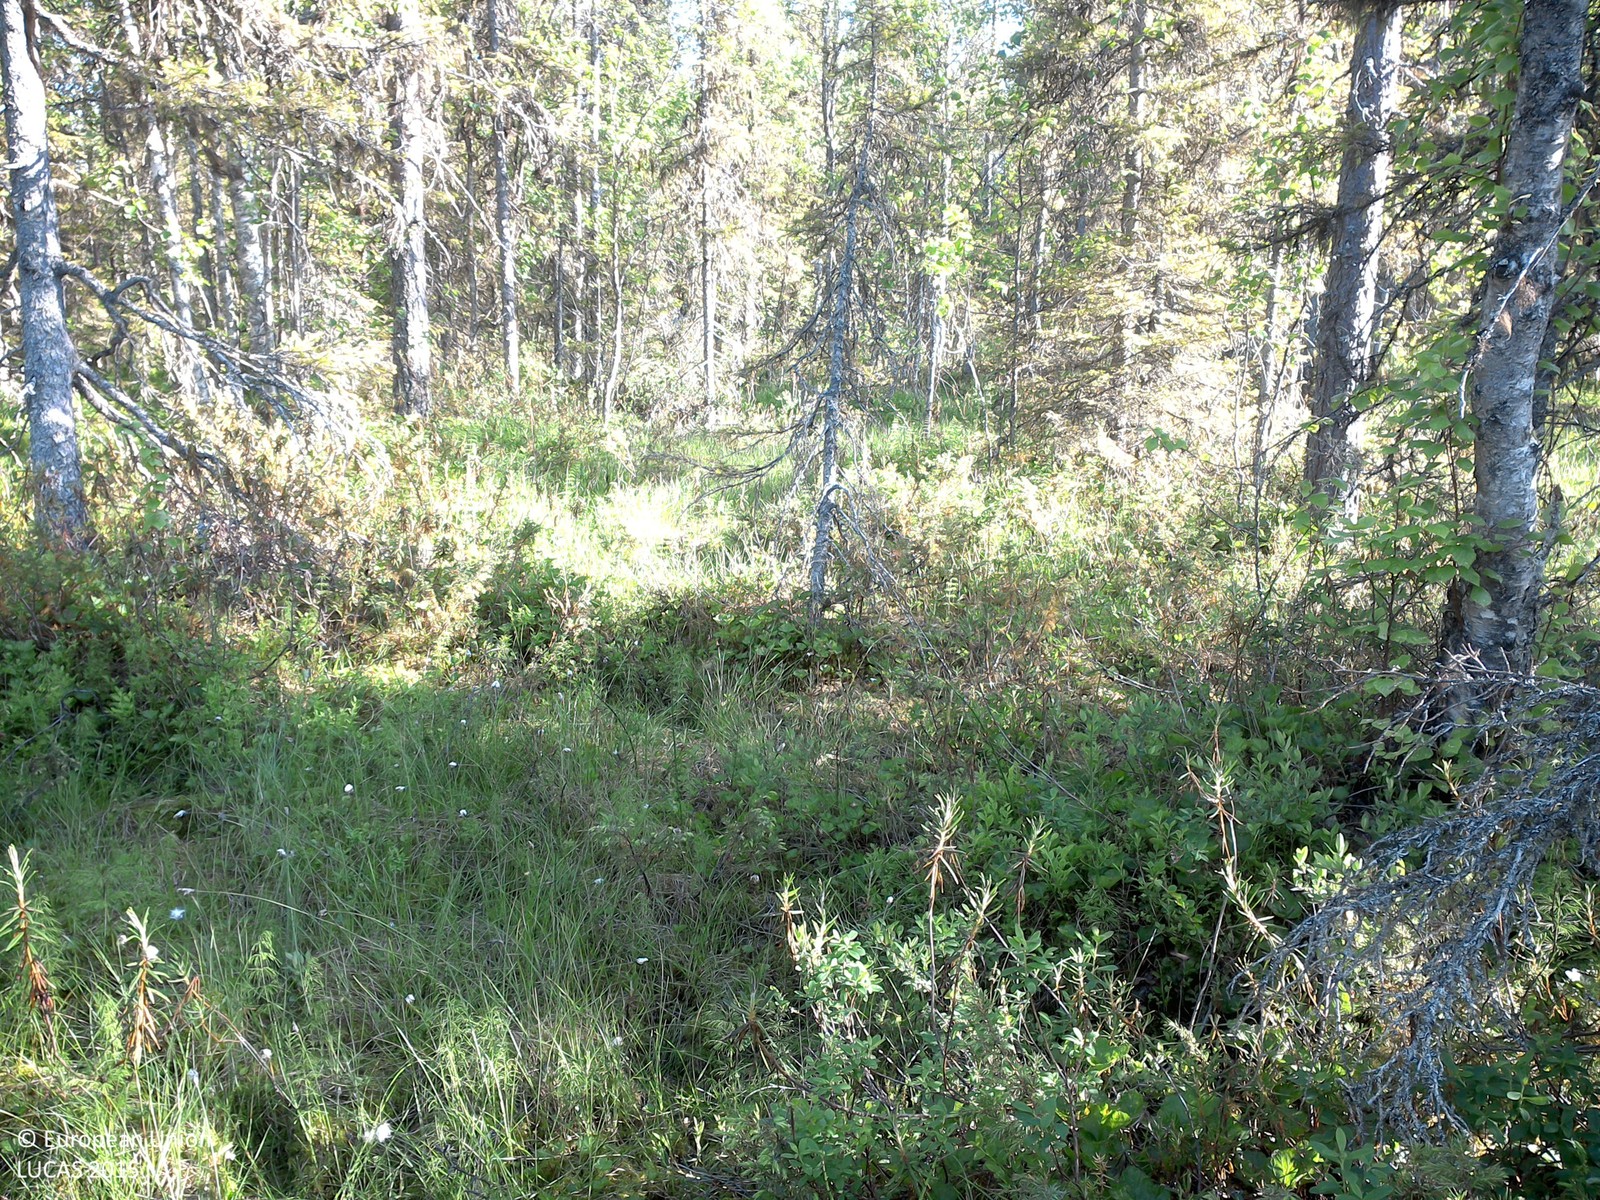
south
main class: Woodland
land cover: Spruce dominated mixed woodland
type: boreal forest
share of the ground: 10 - 25 %
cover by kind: herbaceous plants 35 %, shrubs 30 %, coniferous forest trees 15 %, lichens and mosses 15 %, broadleaved forest trees 5 %
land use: Forestry
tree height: > 5 m
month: July
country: SE
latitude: 66.7211
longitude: 23.5641
